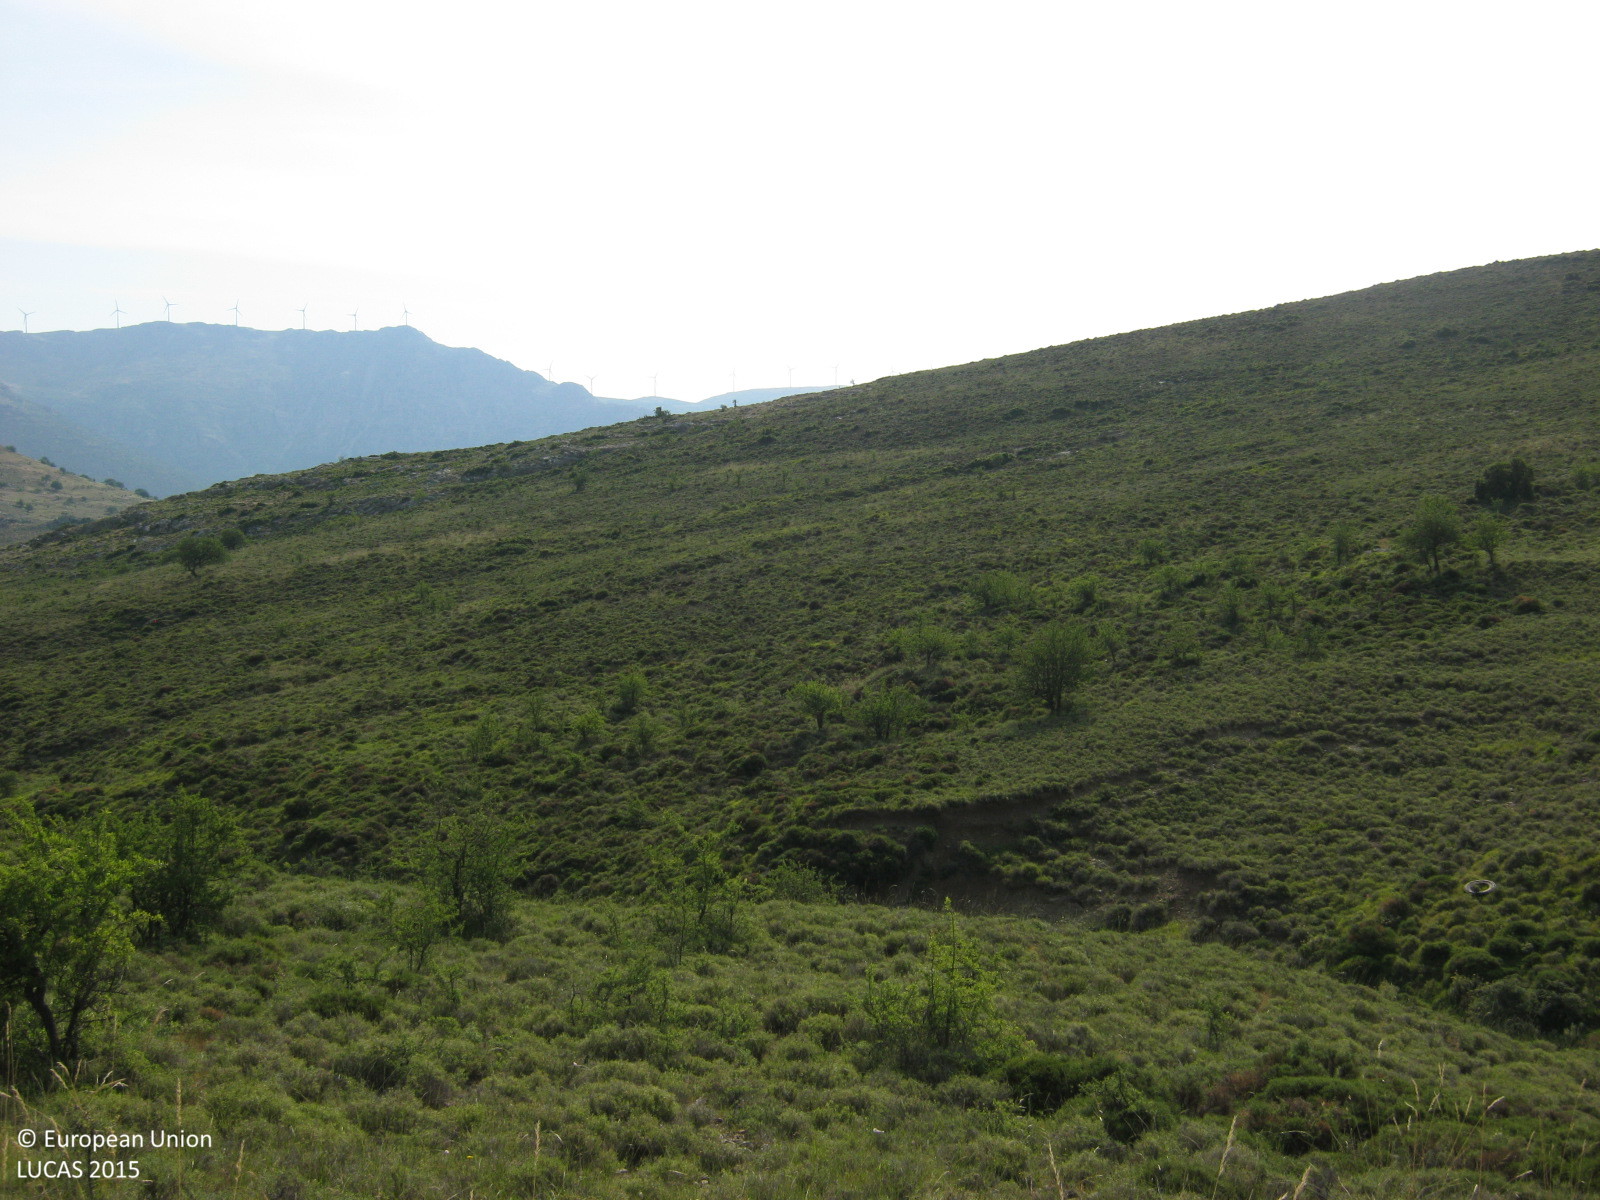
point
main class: Shrubland
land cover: Shrubland without tree cover
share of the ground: > 75 %
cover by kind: shrubs 85 %, herbaceous plants 15 %
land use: Semi-natural and natural areas not in use
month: June
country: GR
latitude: 37.5226
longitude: 22.5112
